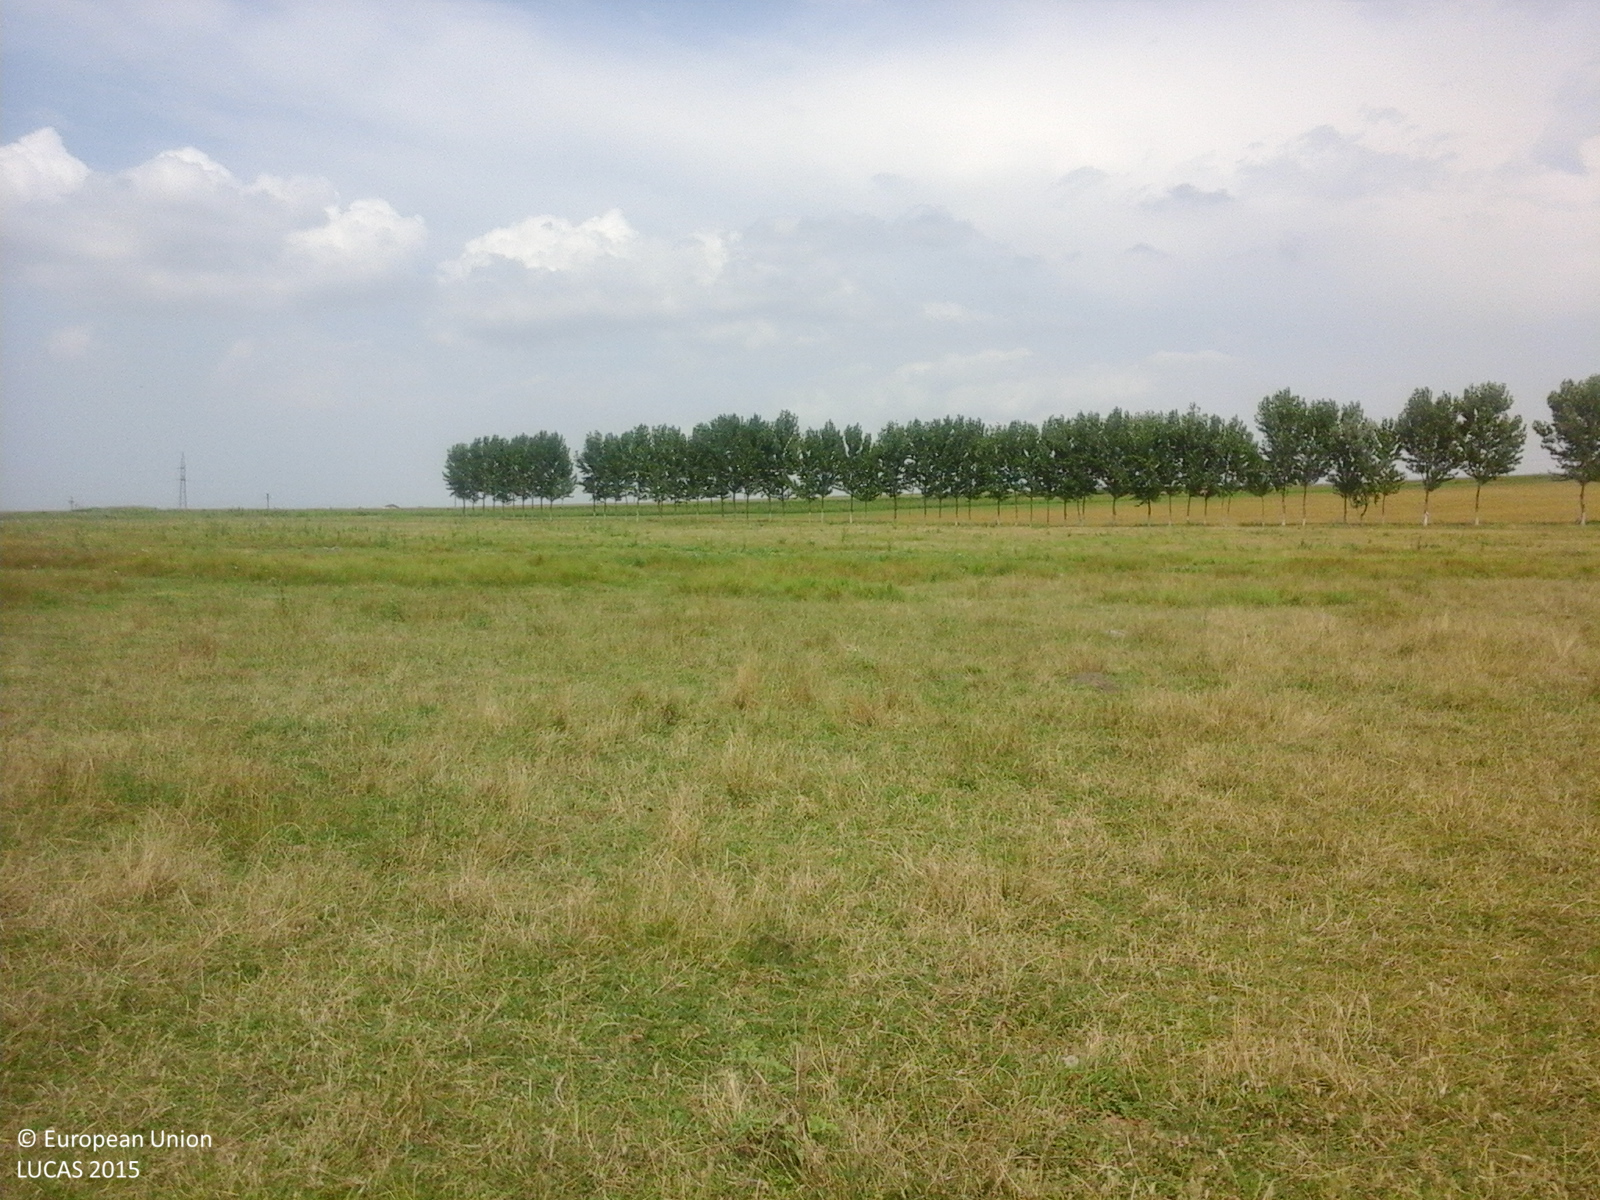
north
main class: Grassland
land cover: Grassland without tree/shrub cover
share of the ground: > 75 %
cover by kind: herbaceous plants 100 %
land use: Agriculture (excluding fallow land and kitchen gardens)
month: July
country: RO
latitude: 45.0062
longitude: 28.7495
